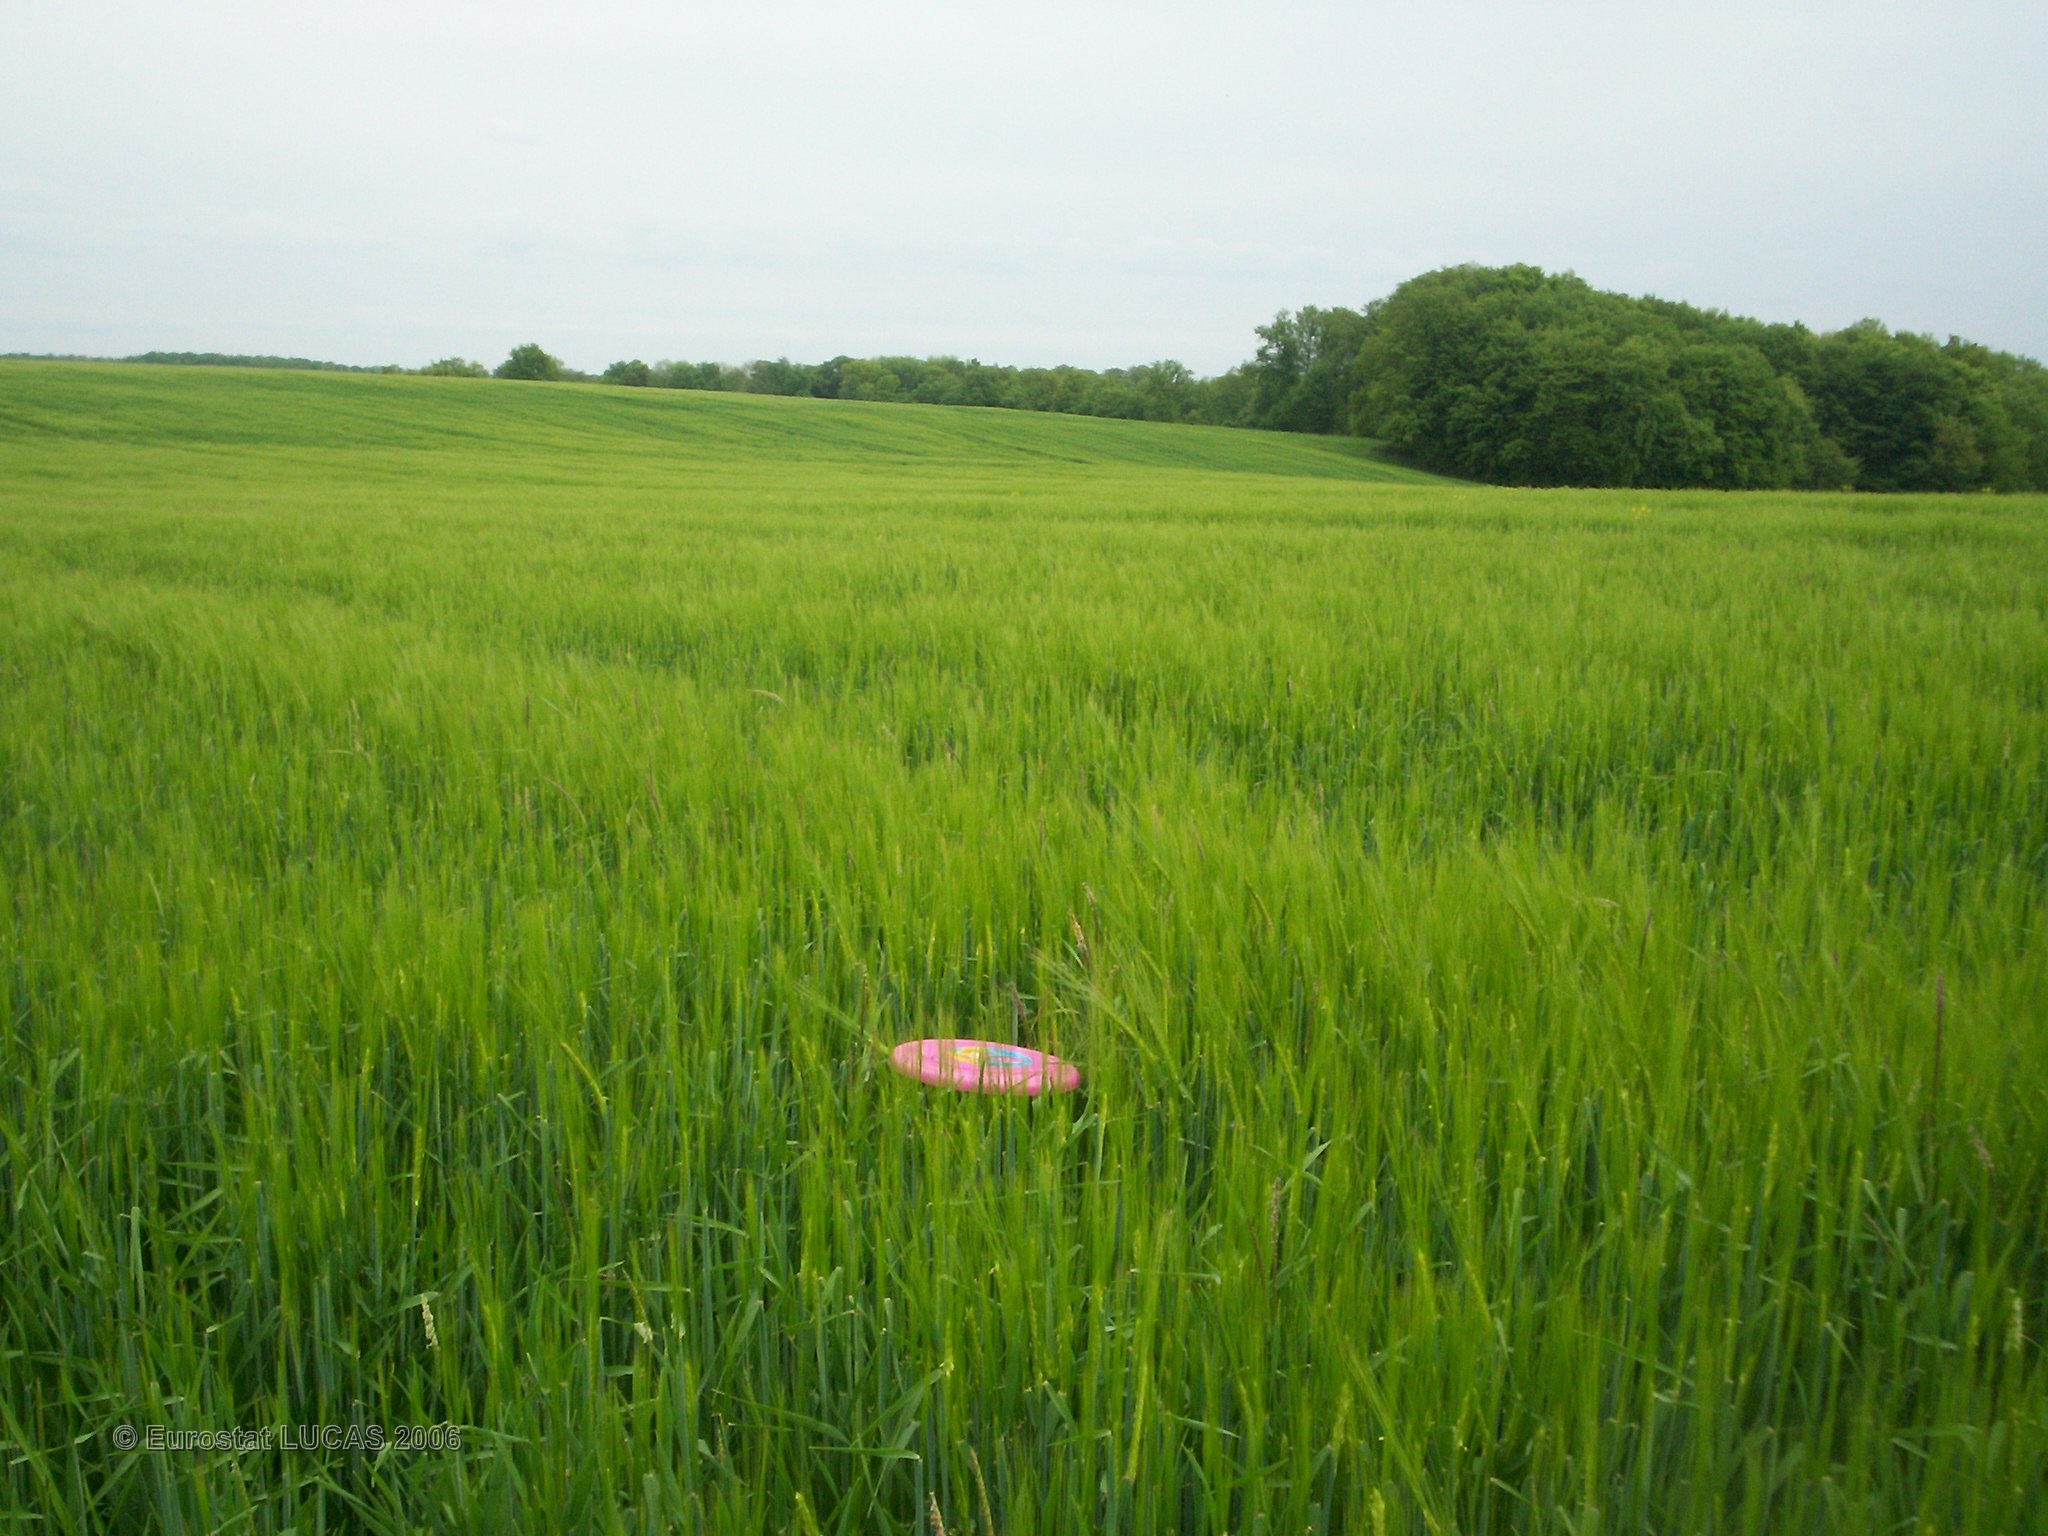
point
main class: Cropland
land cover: Barley
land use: Agriculture (excluding fallow land and kitchen gardens)
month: May
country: FR
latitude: 47.7134
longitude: 3.0226
